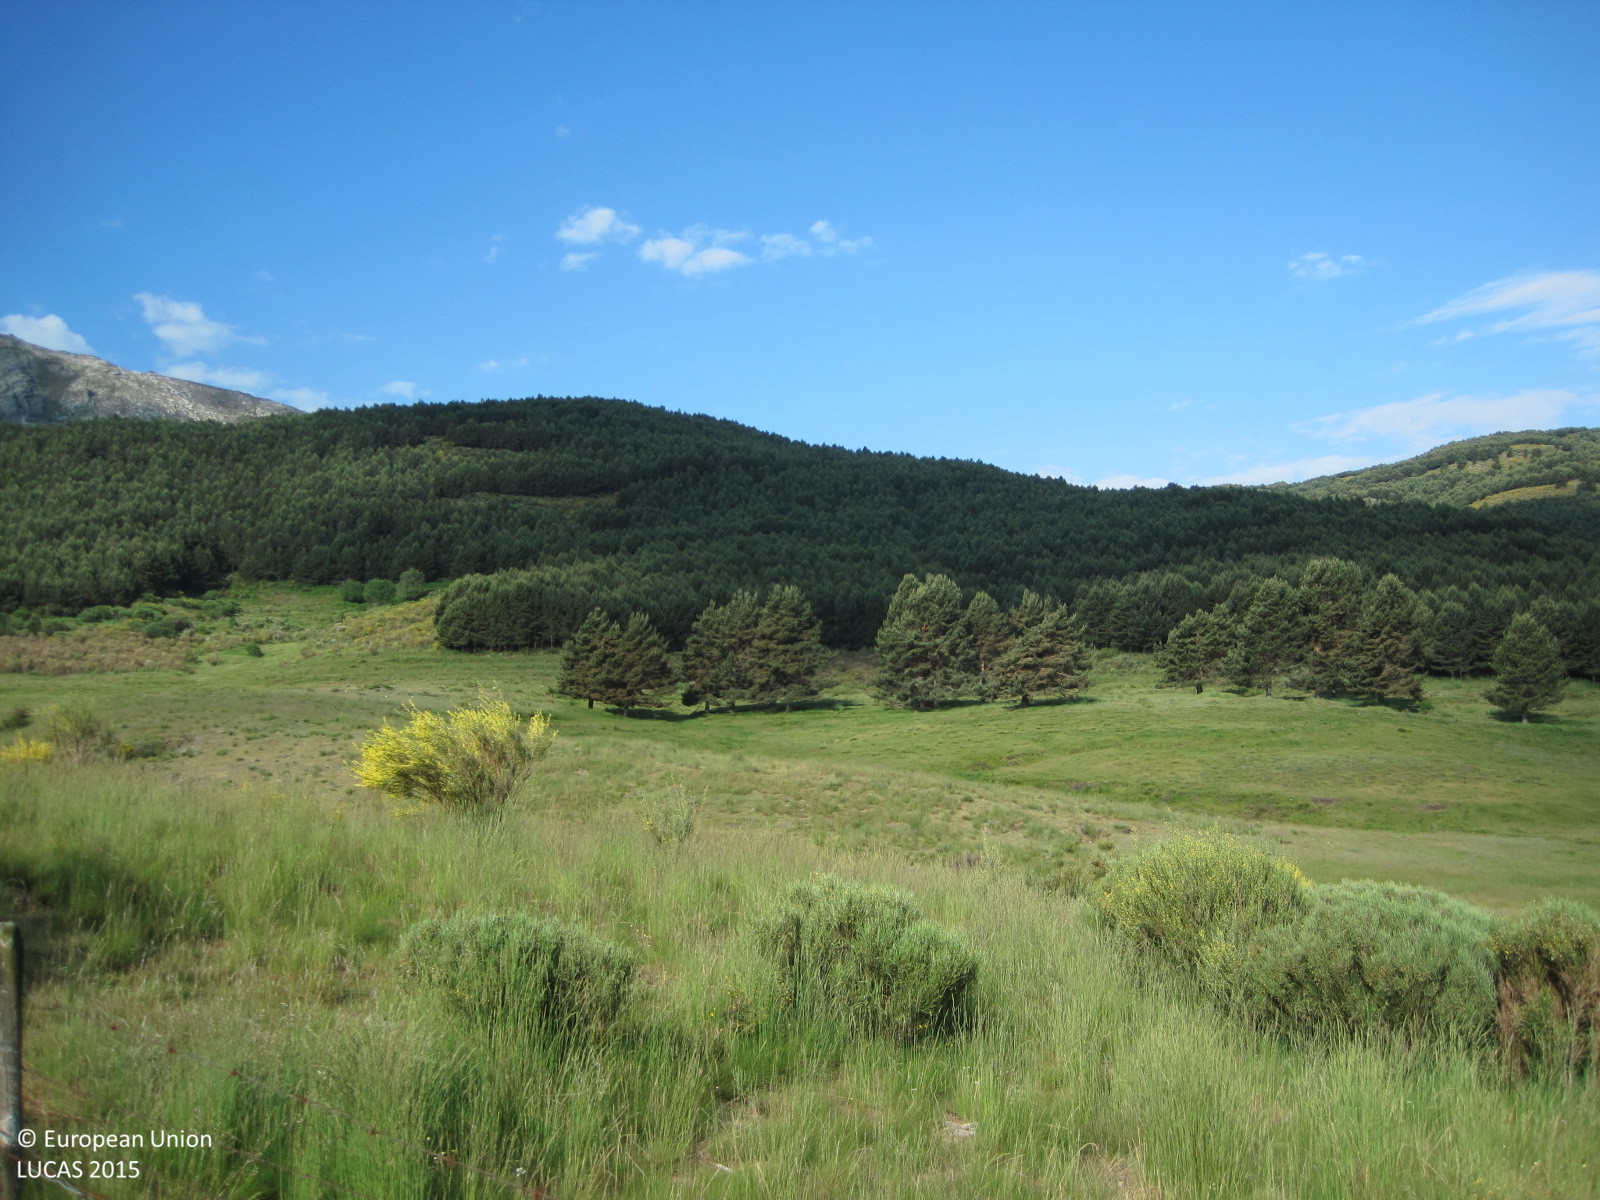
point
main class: Woodland
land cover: Pine dominated coniferous woodland
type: coniferous forest of the mediterranean region
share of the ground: > 75 %
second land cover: Grassland without tree/shrub cover
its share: 50 - 75 %
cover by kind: coniferous forest trees 95 %, herbaceous plants 5 %
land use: Forestry
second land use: Agriculture (excluding fallow land and kitchen gardens)
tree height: > 5 m
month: June
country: ES
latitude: 40.3345
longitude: -5.0171
